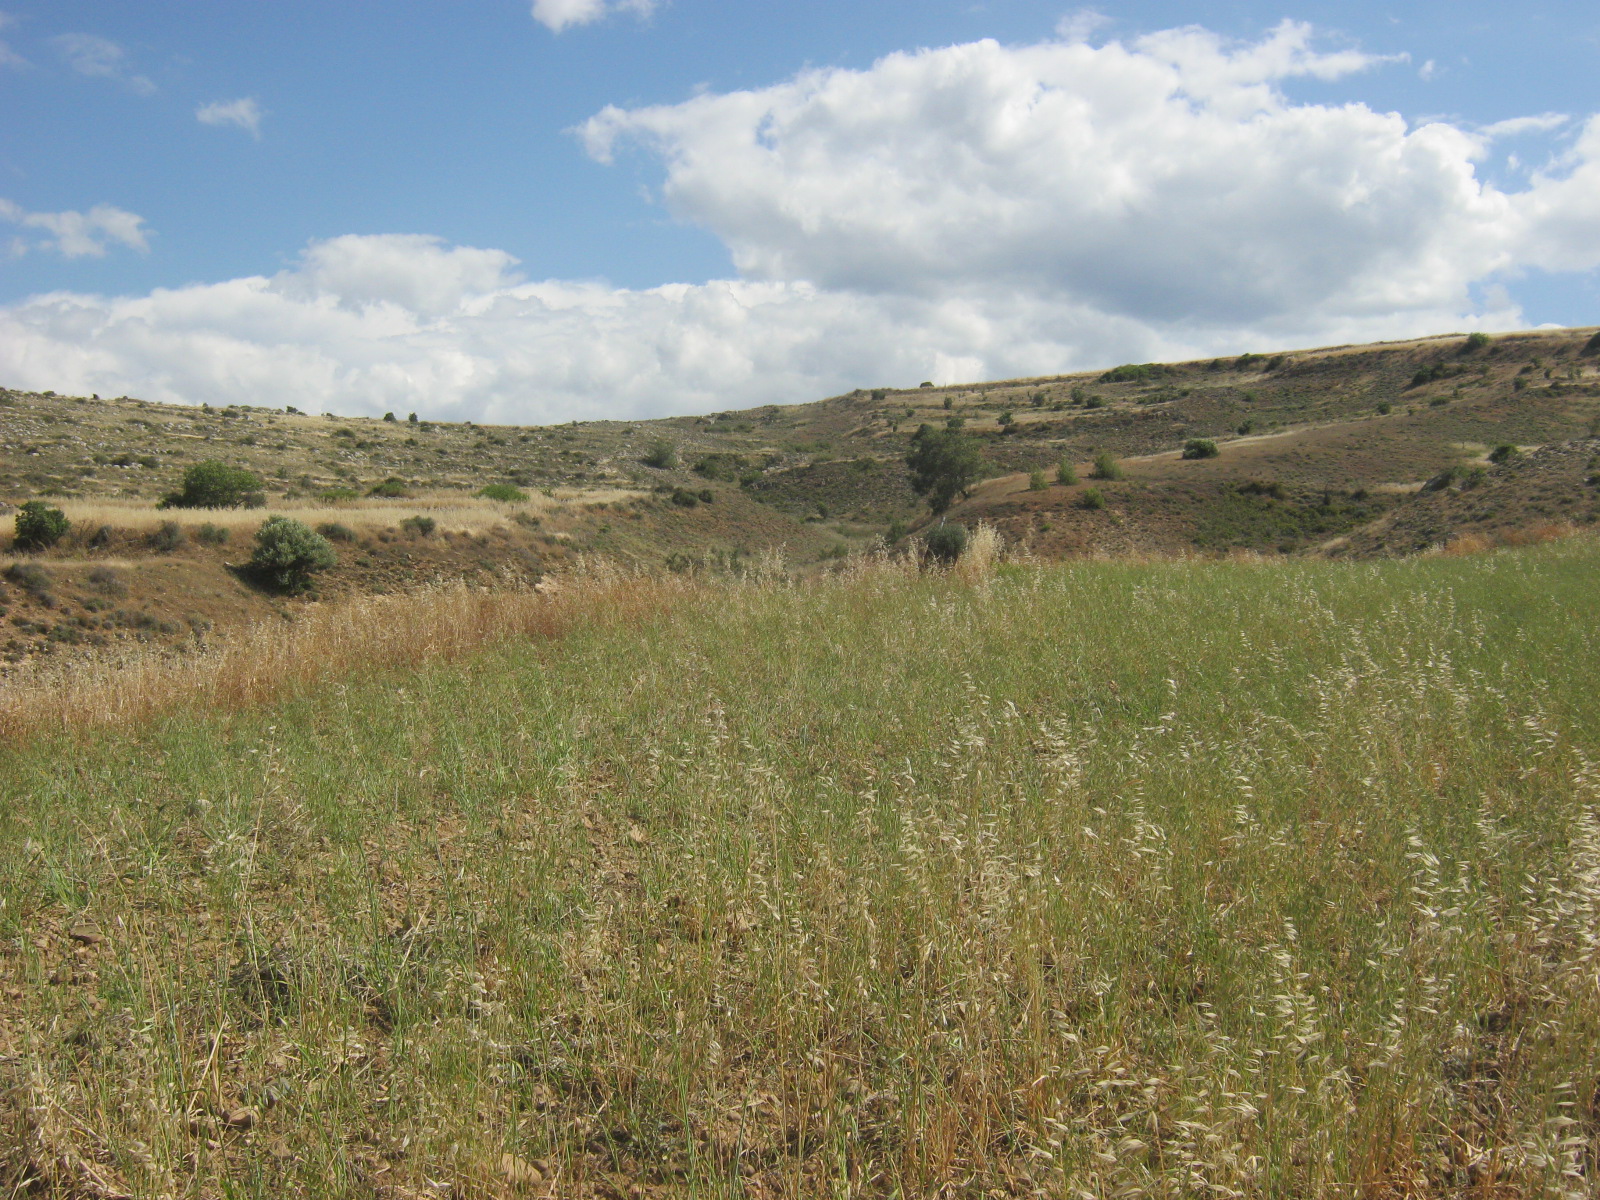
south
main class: Grassland
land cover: Spontaneously vegetated surfaces
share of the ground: > 75 %
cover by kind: herbaceous plants 80 %, unconsolidated bare surface 20 %
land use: Fallow land
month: May
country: CY
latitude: 35.0876
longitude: 33.0251
